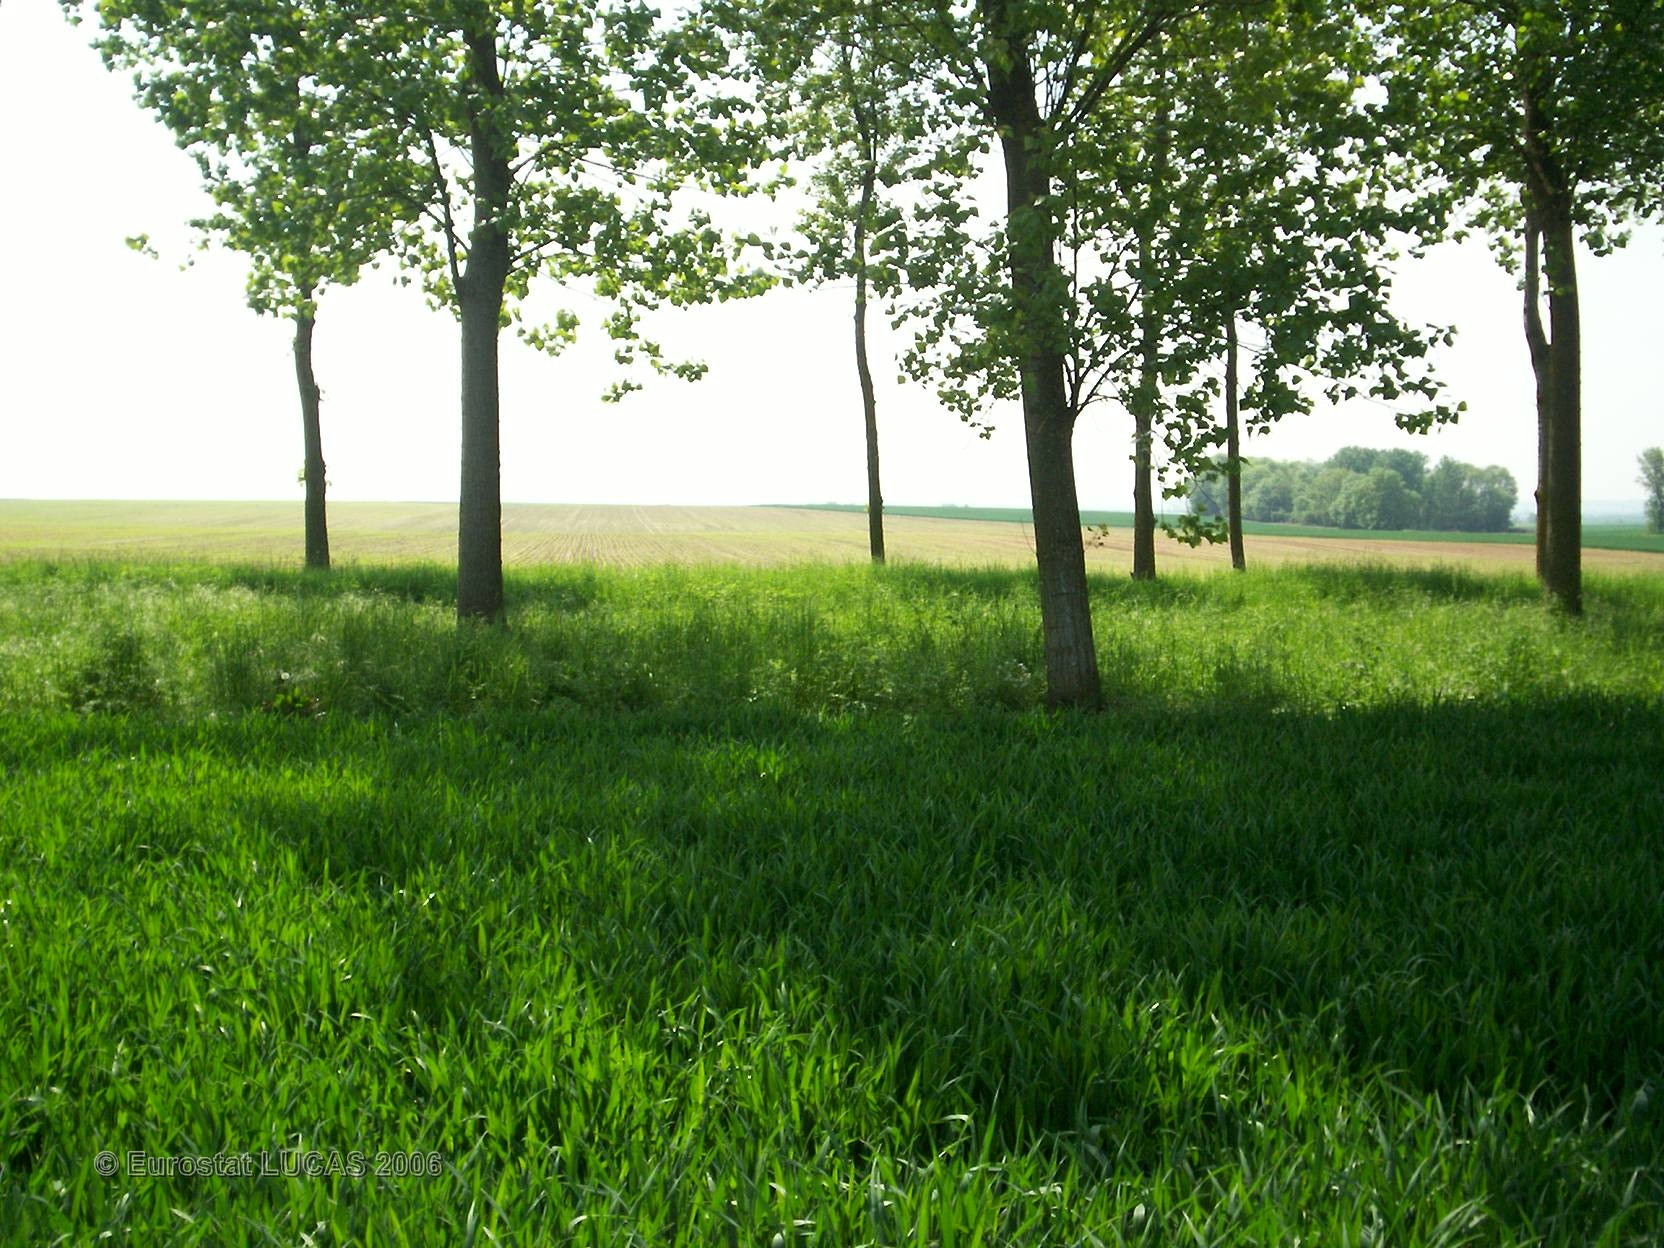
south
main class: Cropland
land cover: Common wheat
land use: Agriculture (excluding fallow land and kitchen gardens)
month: May
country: FR
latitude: 48.9807
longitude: 2.7894
